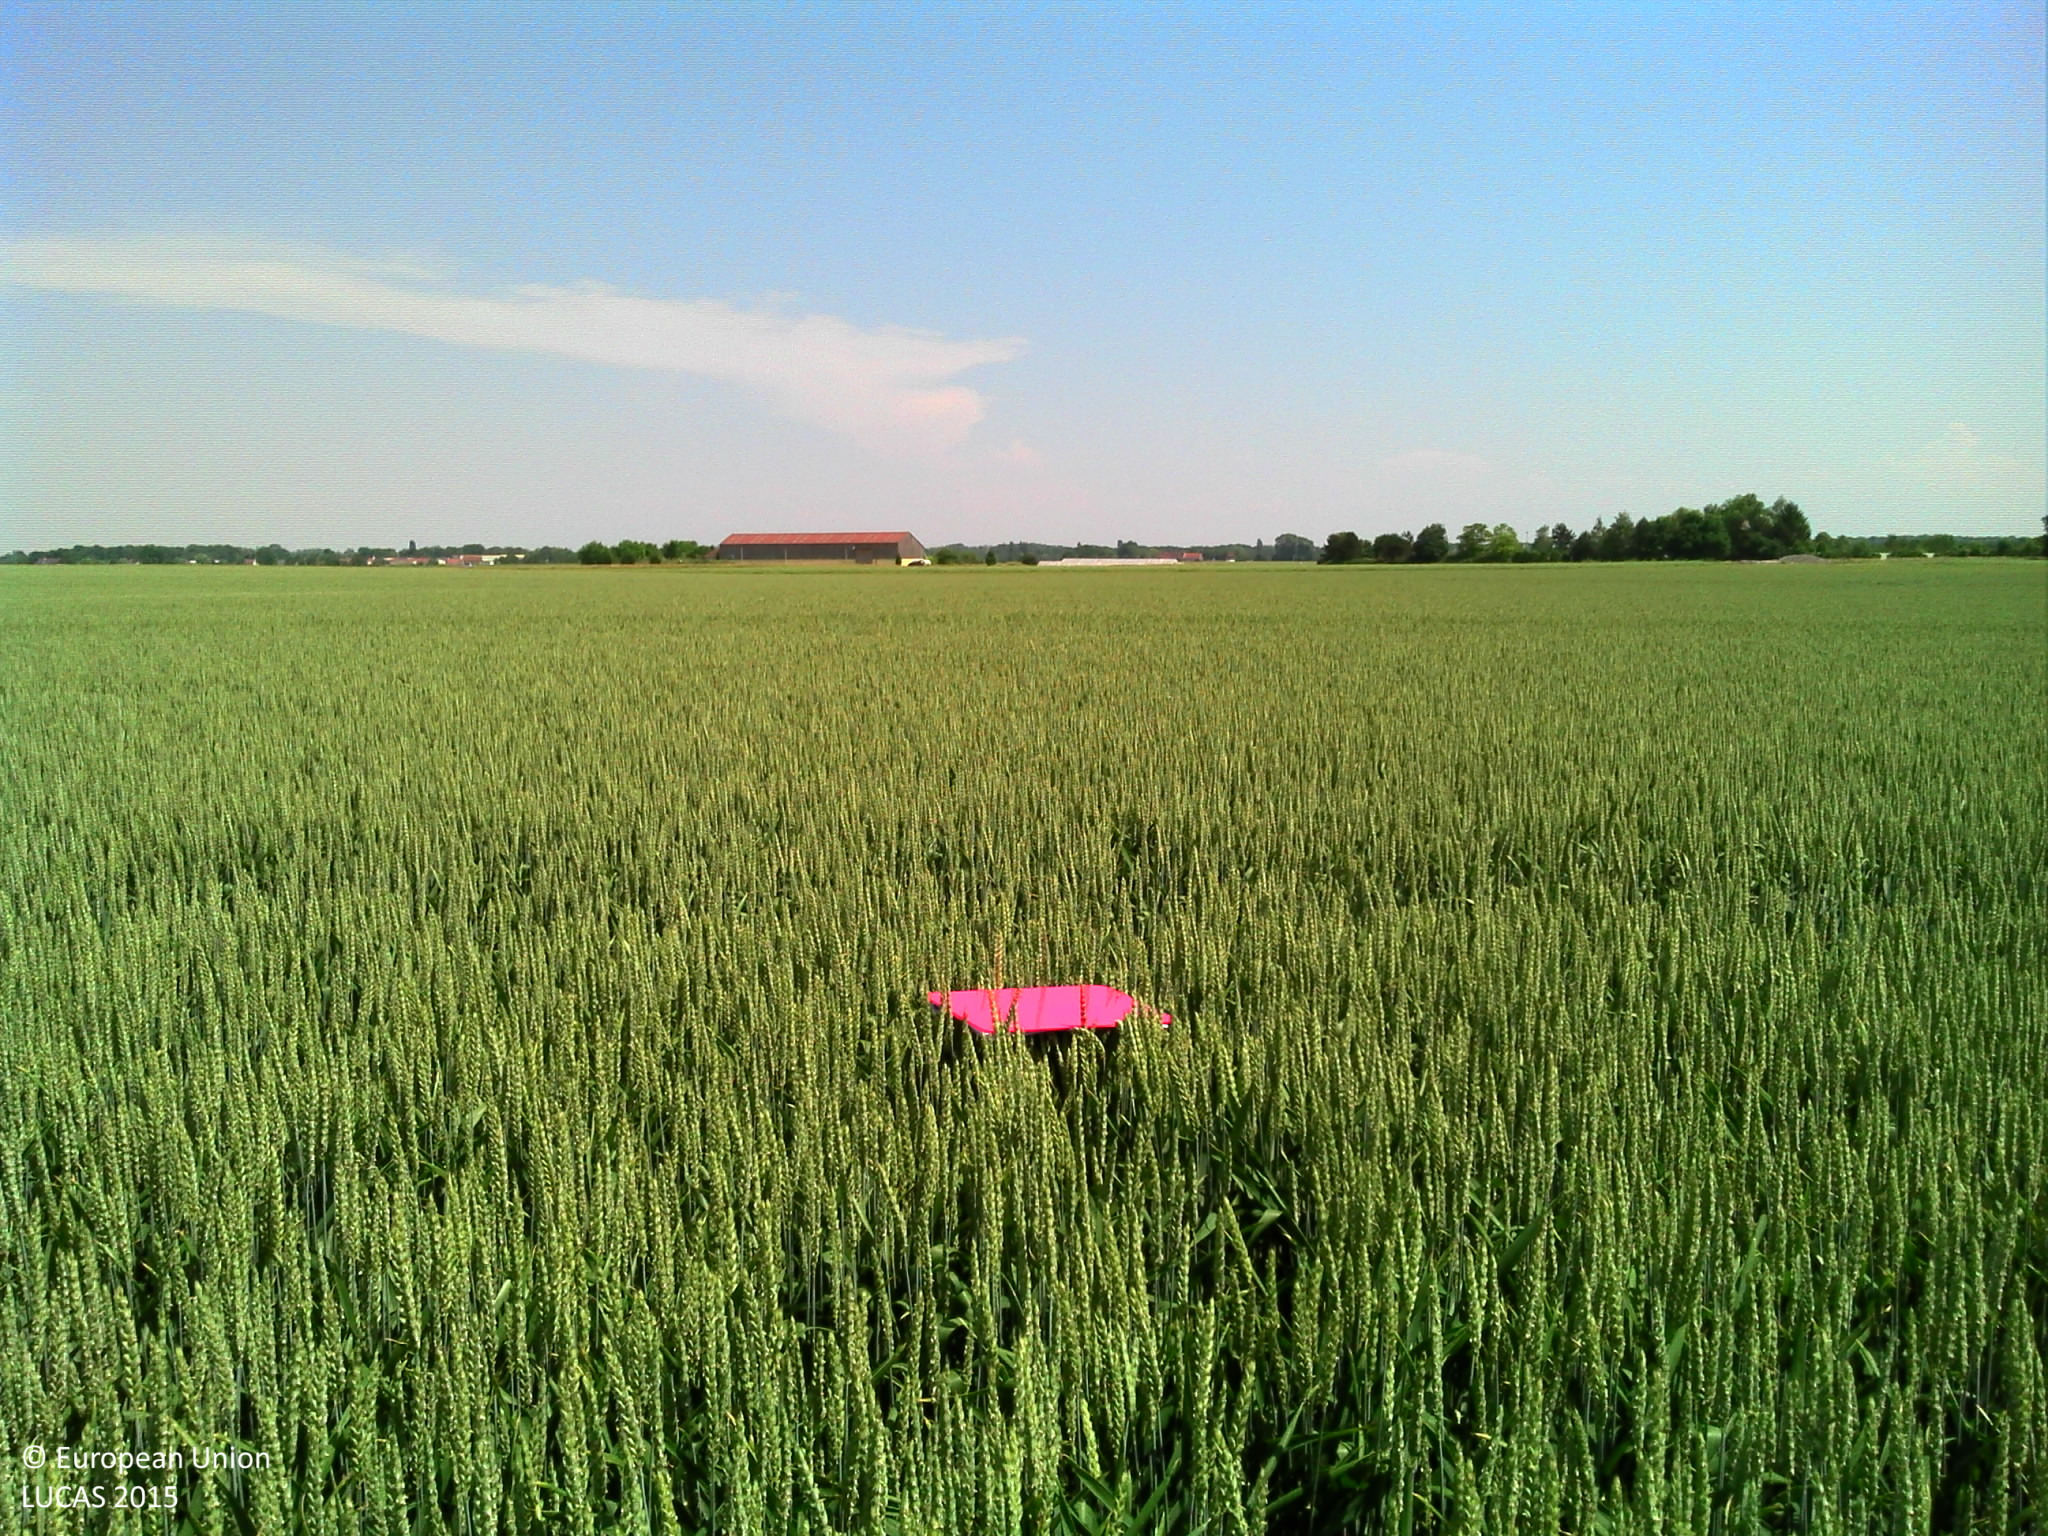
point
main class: Cropland
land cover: Common wheat
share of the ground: > 75 %
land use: Agriculture (excluding fallow land and kitchen gardens)
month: June
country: FR
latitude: 47.3221
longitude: 5.1185
